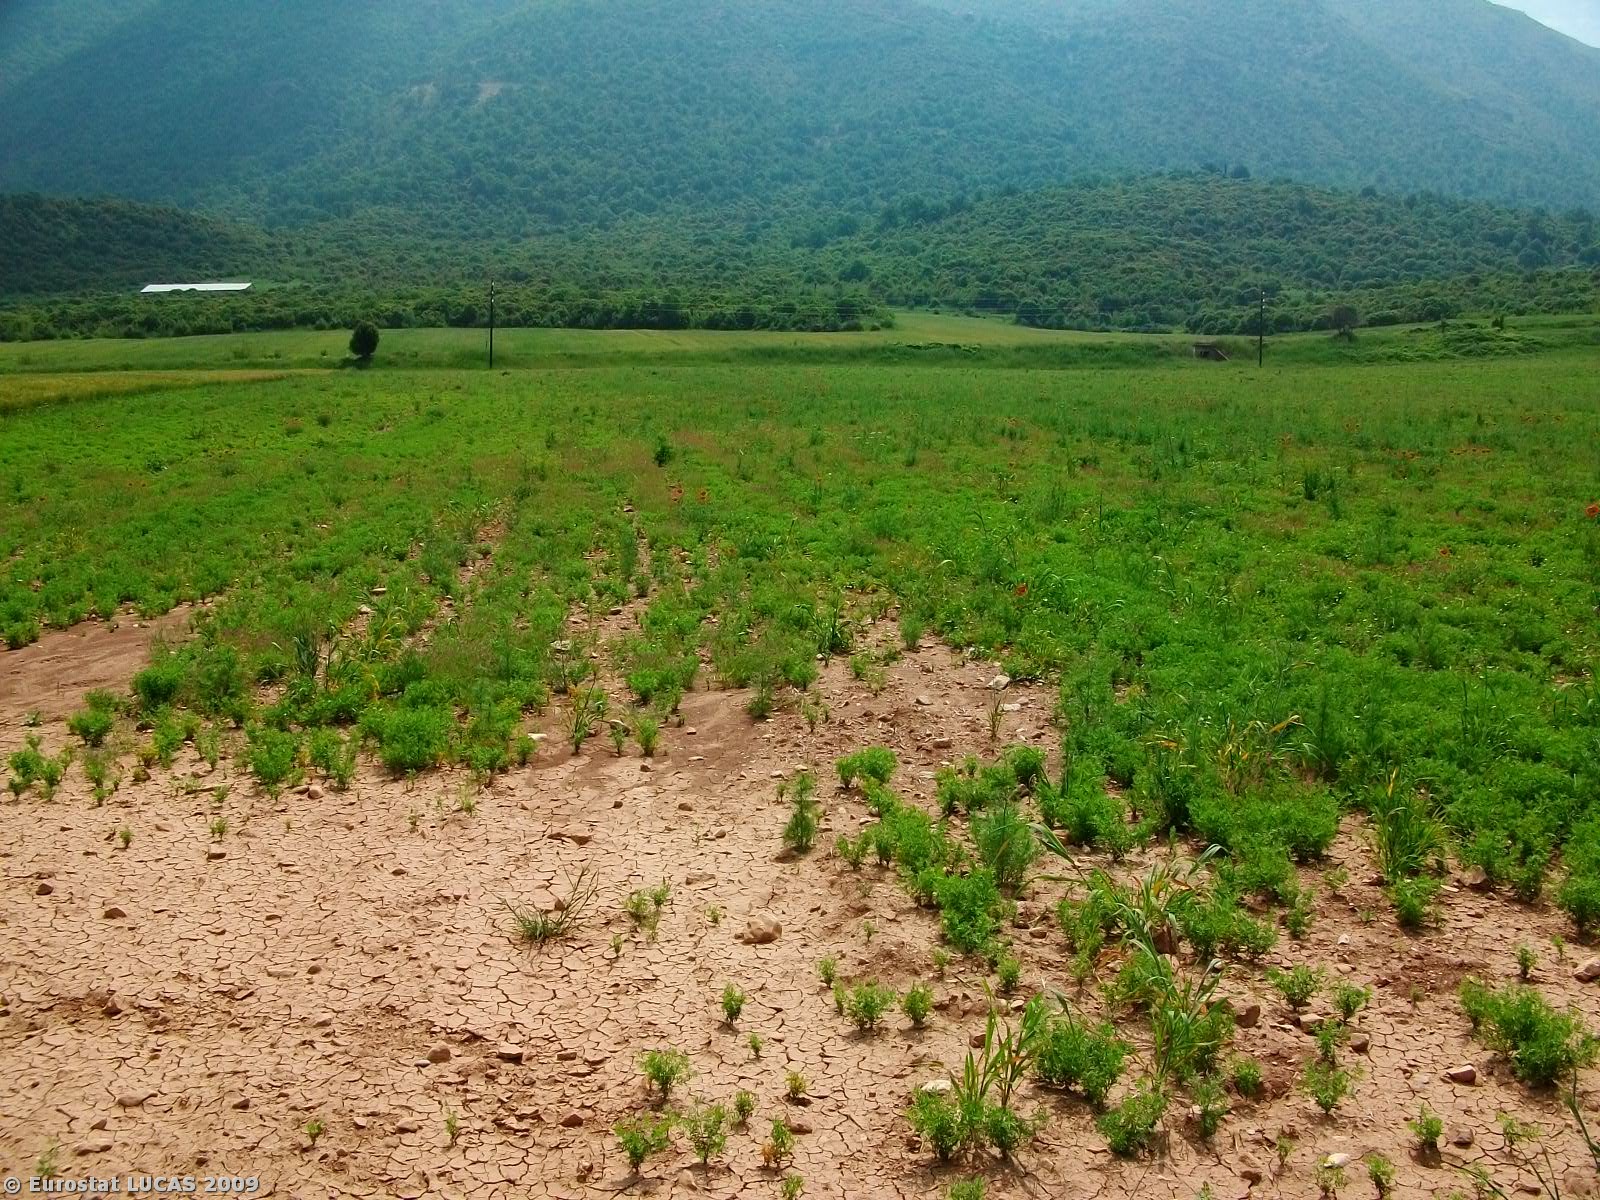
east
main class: Cropland
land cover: Dry pulses
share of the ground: 10 - 25 %
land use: Agriculture (excluding fallow land and kitchen gardens)
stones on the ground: 10 - 25 %
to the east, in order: Dry pulses; Electric lines; Single bushes/trees; Grass margins; Paved roads, cycling and walking lanes; Grass margins; Barley
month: May
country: GR
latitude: 39.9451
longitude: 21.7264
